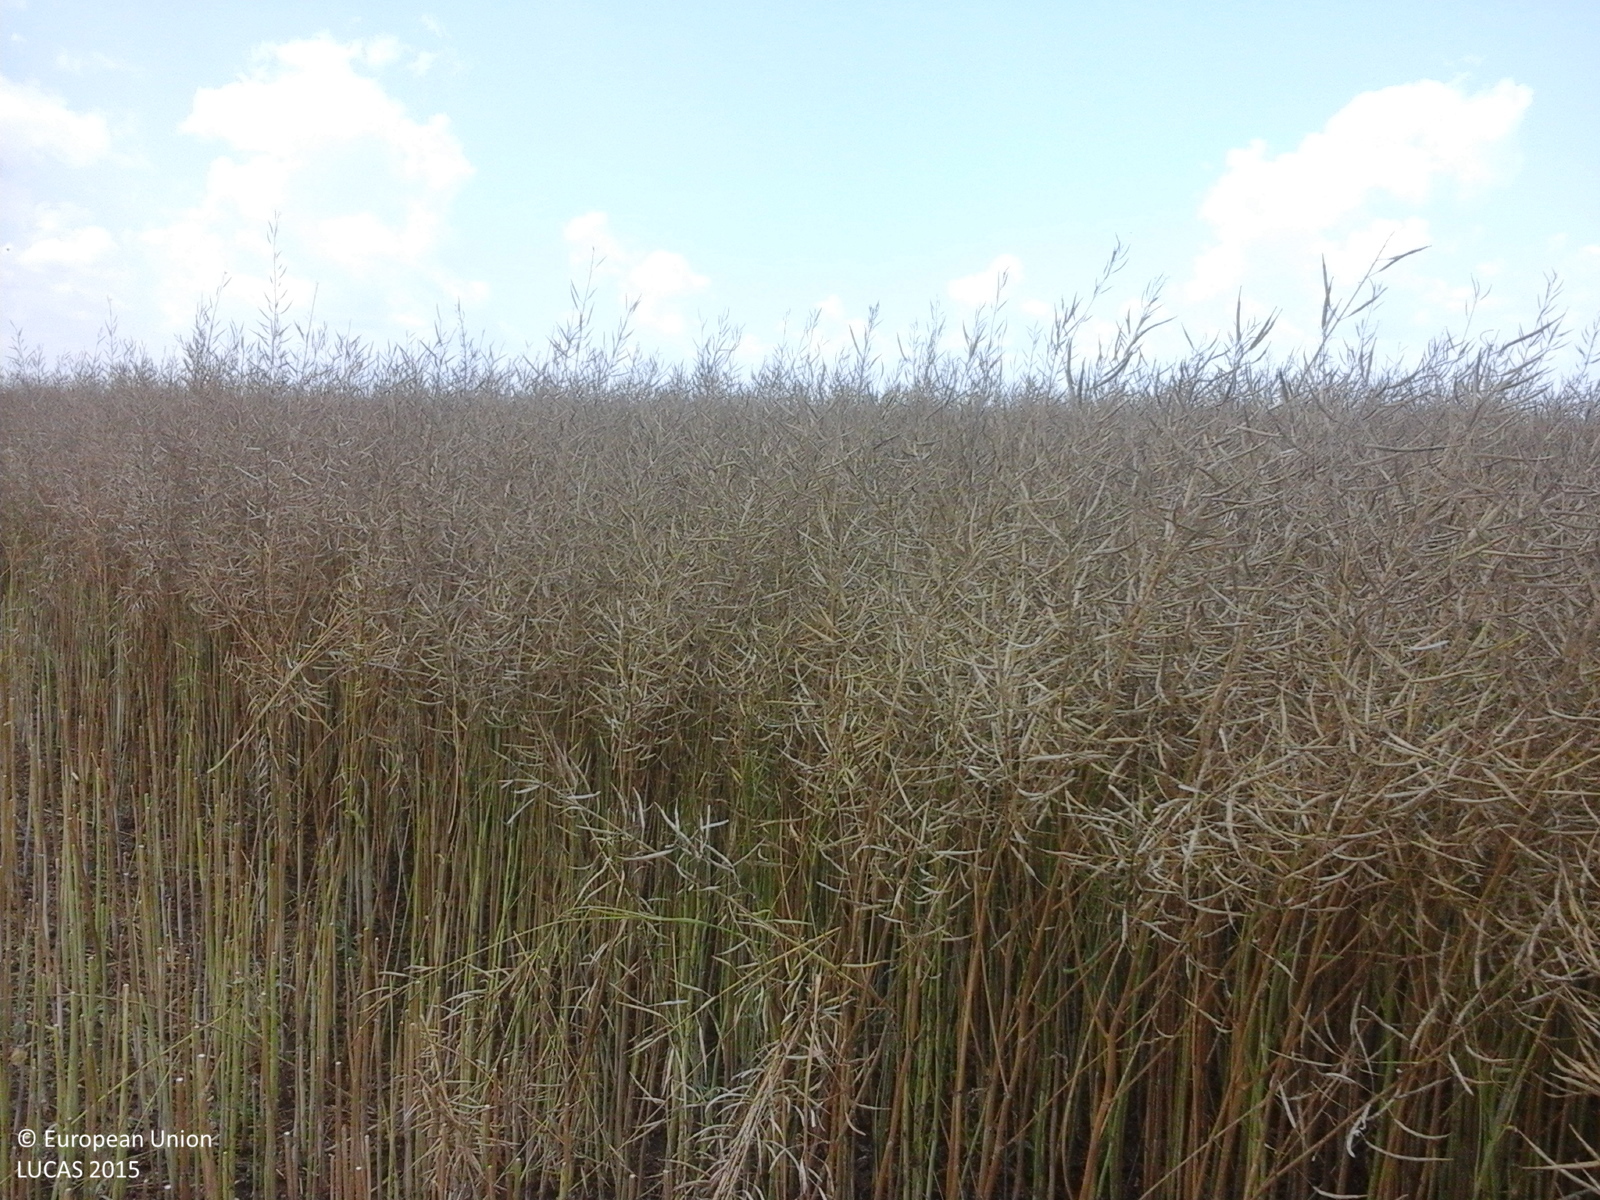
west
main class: Cropland
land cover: Rape and turnip rape
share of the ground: > 75 %
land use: Agriculture (excluding fallow land and kitchen gardens)
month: July
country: RO
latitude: 44.0772
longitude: 25.9693
